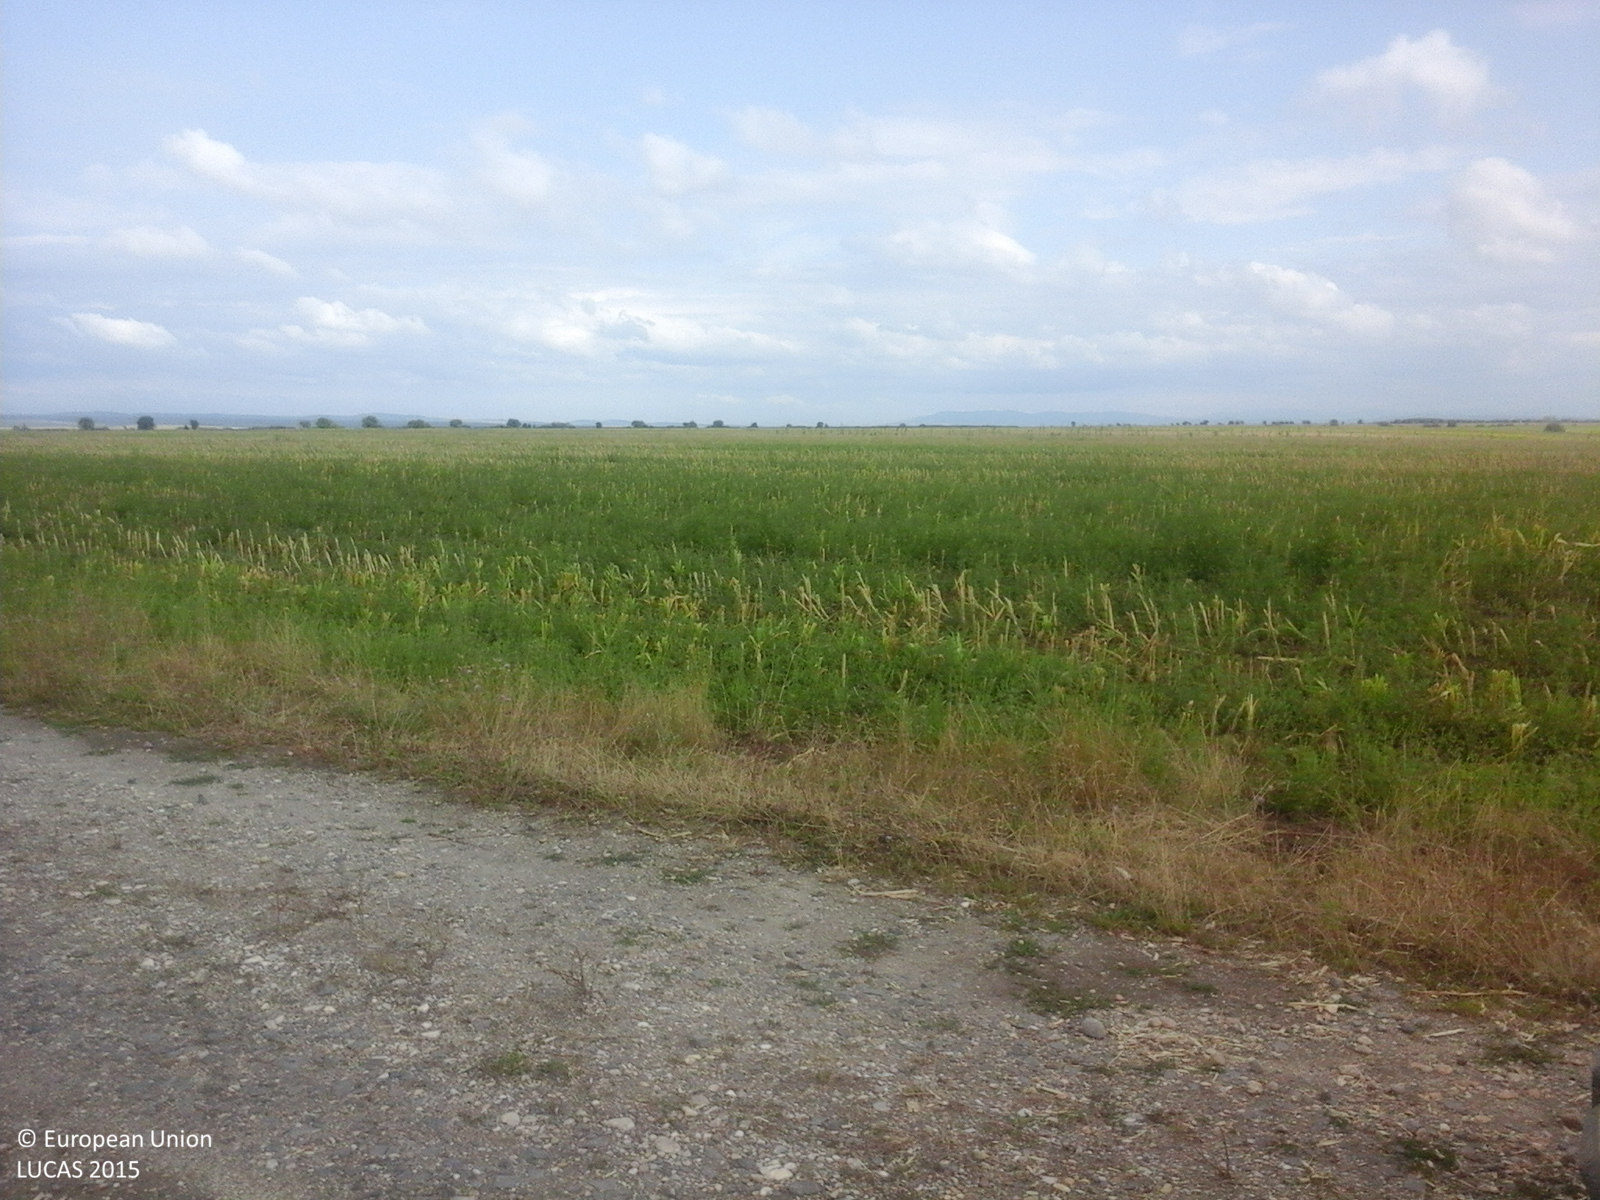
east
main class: Cropland
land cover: Sunflower
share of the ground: > 75 %
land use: Agriculture (excluding fallow land and kitchen gardens)
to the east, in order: Sunflower; Grass margins; Tracks; Grass margins; Maize
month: August
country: RO
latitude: 45.5528
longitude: 21.4453
